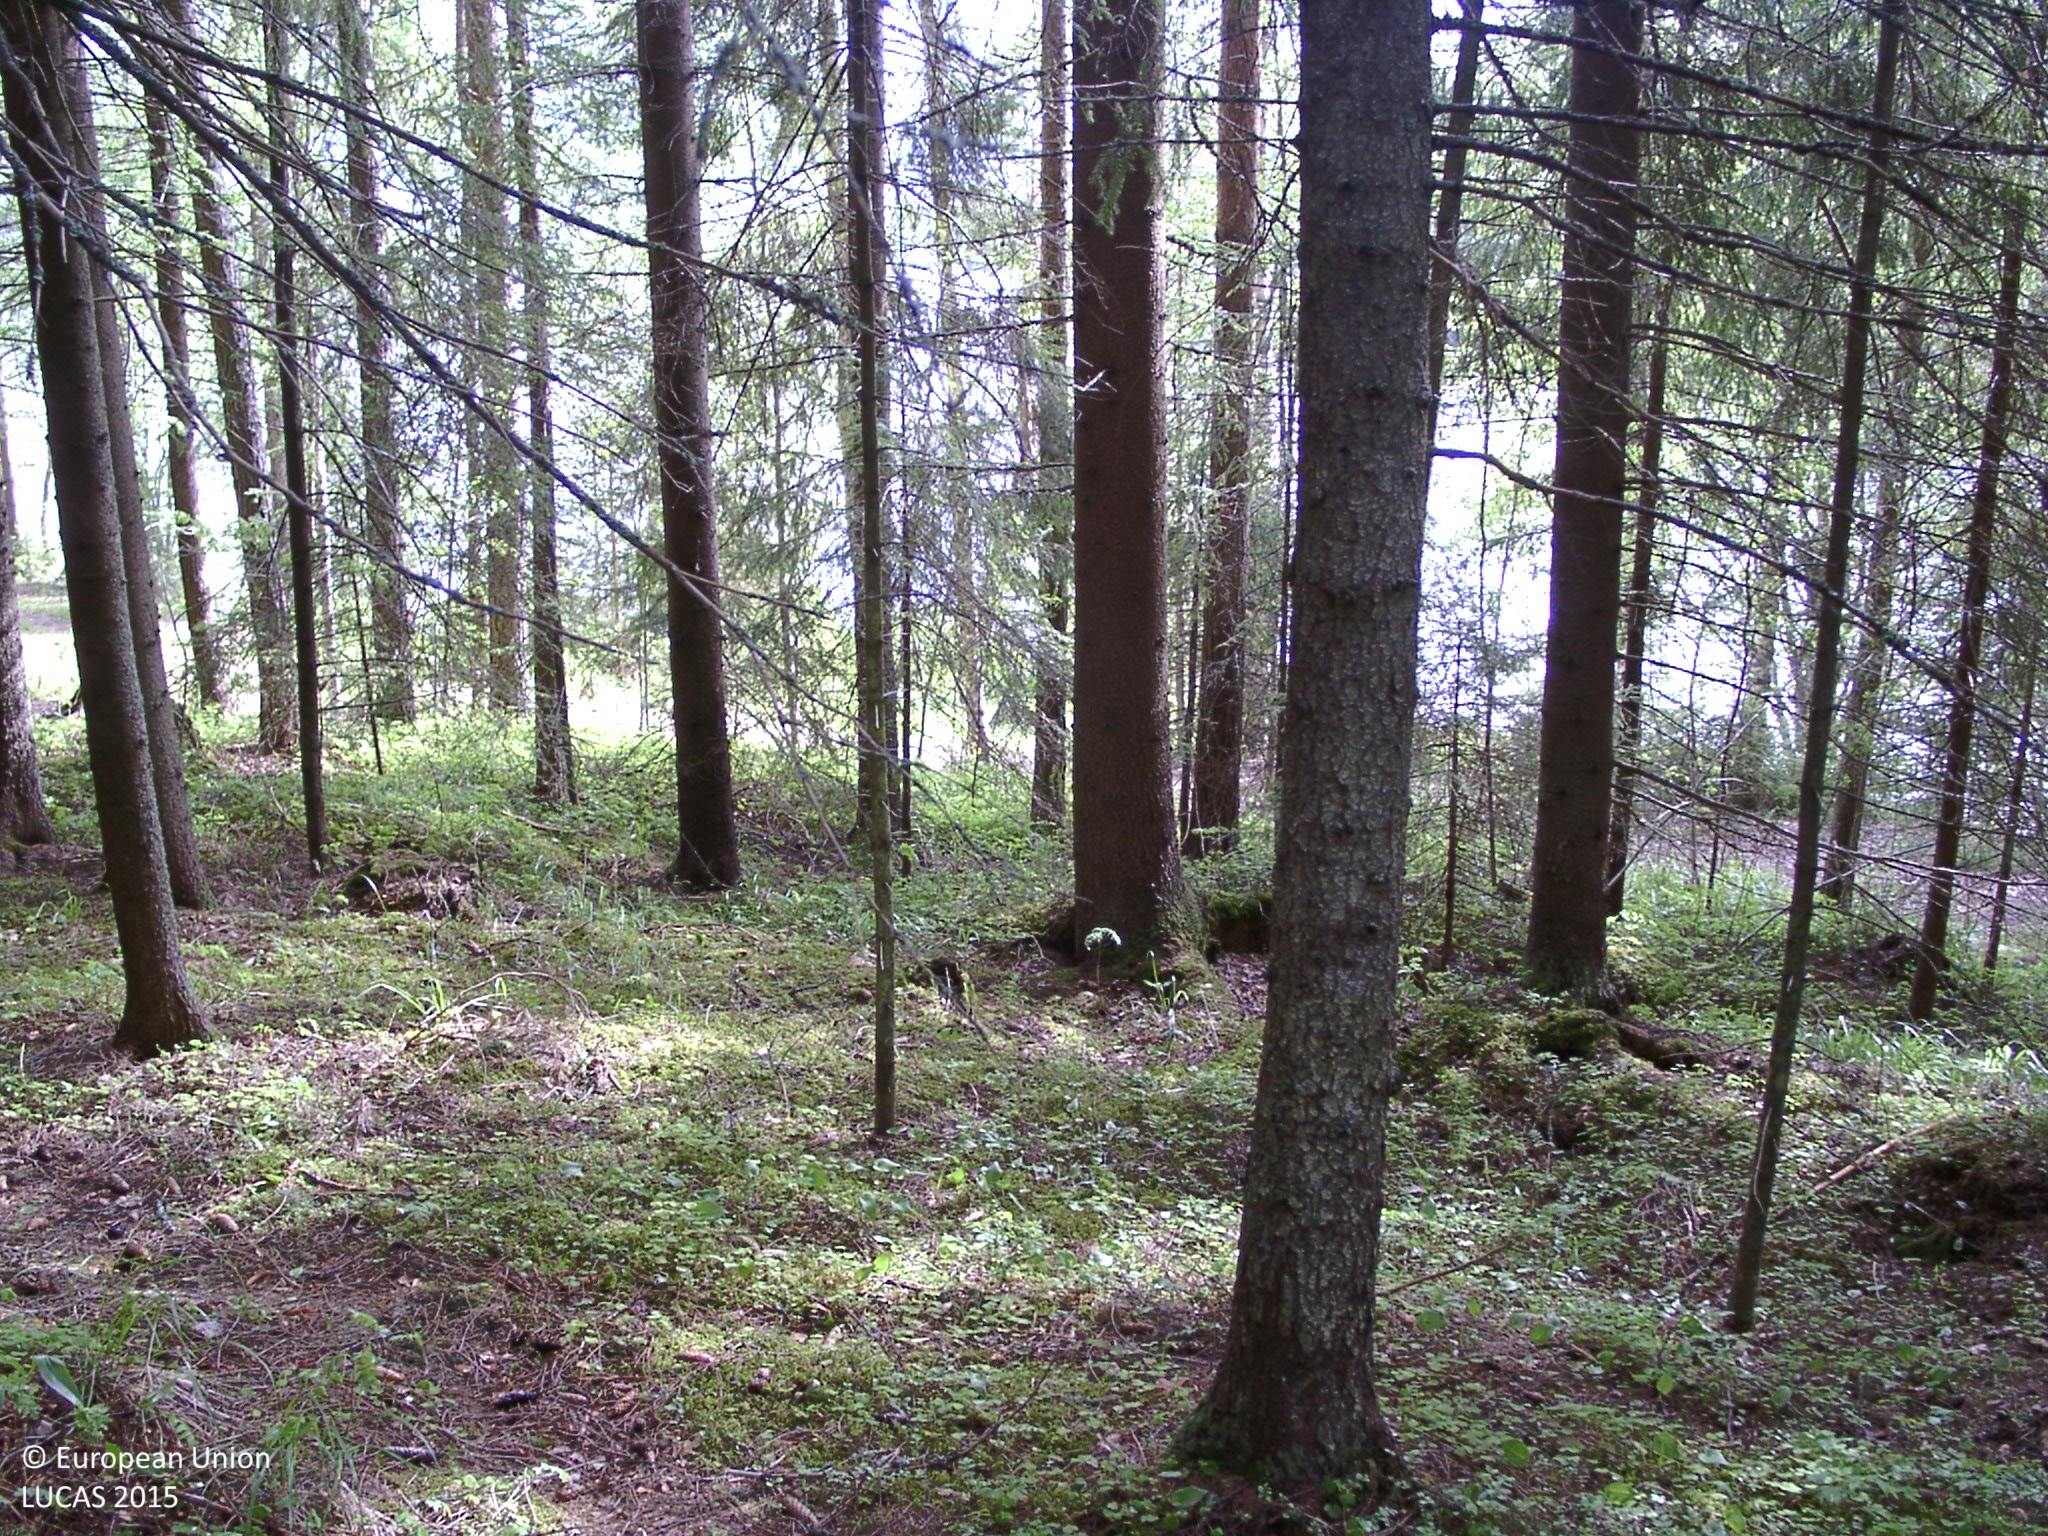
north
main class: Woodland
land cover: Spruce dominated coniferous woodland
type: boreal forest
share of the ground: > 75 %
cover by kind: coniferous forest trees 80 %, herbaceous plants 10 %, broadleaved forest trees 5 %, lichens and mosses 5 %
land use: Forestry
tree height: > 5 m
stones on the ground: < 10 %
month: June
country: FI
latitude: 62.1677
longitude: 25.5329
